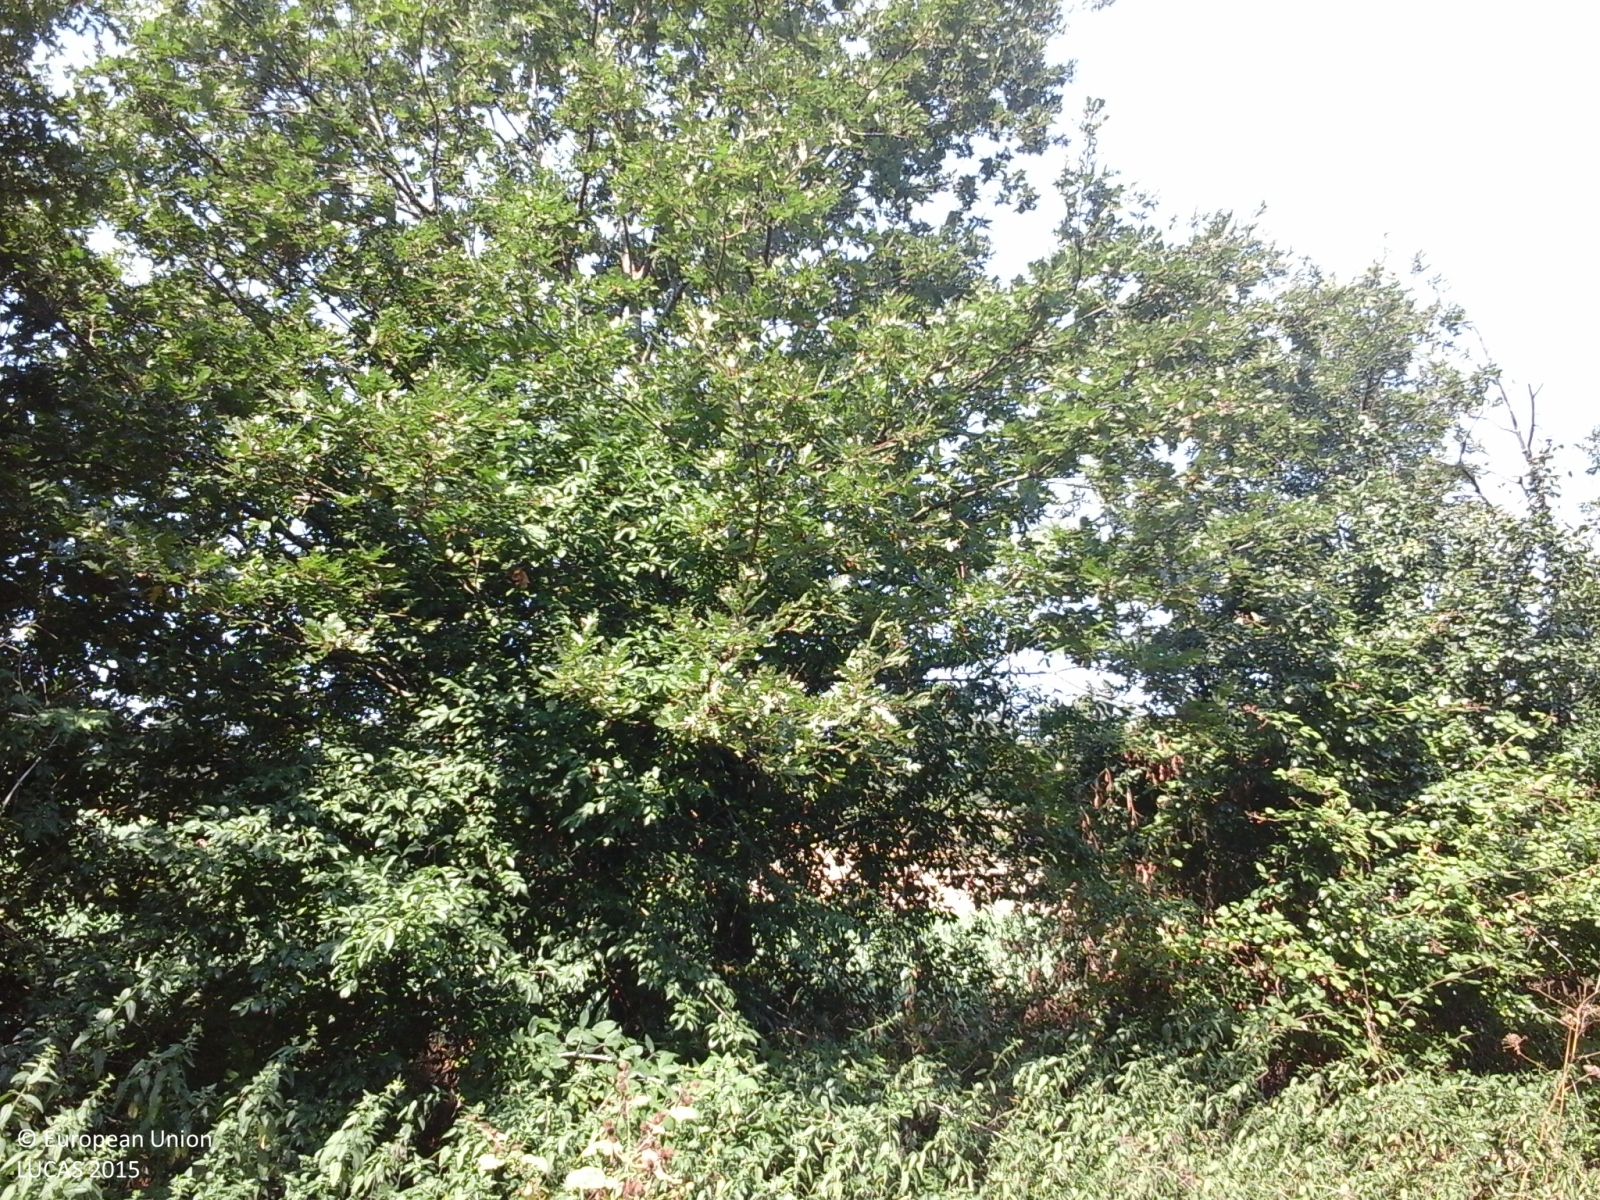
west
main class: Woodland
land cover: Broadleaved woodland
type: thermophilous deciduous forest
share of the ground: > 75 %
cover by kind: broadleaved forest trees 80 %, shrubs 15 %, herbaceous plants 5 %
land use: Forestry
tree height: > 5 m
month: August
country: IT
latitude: 41.3484
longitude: 15.1093
